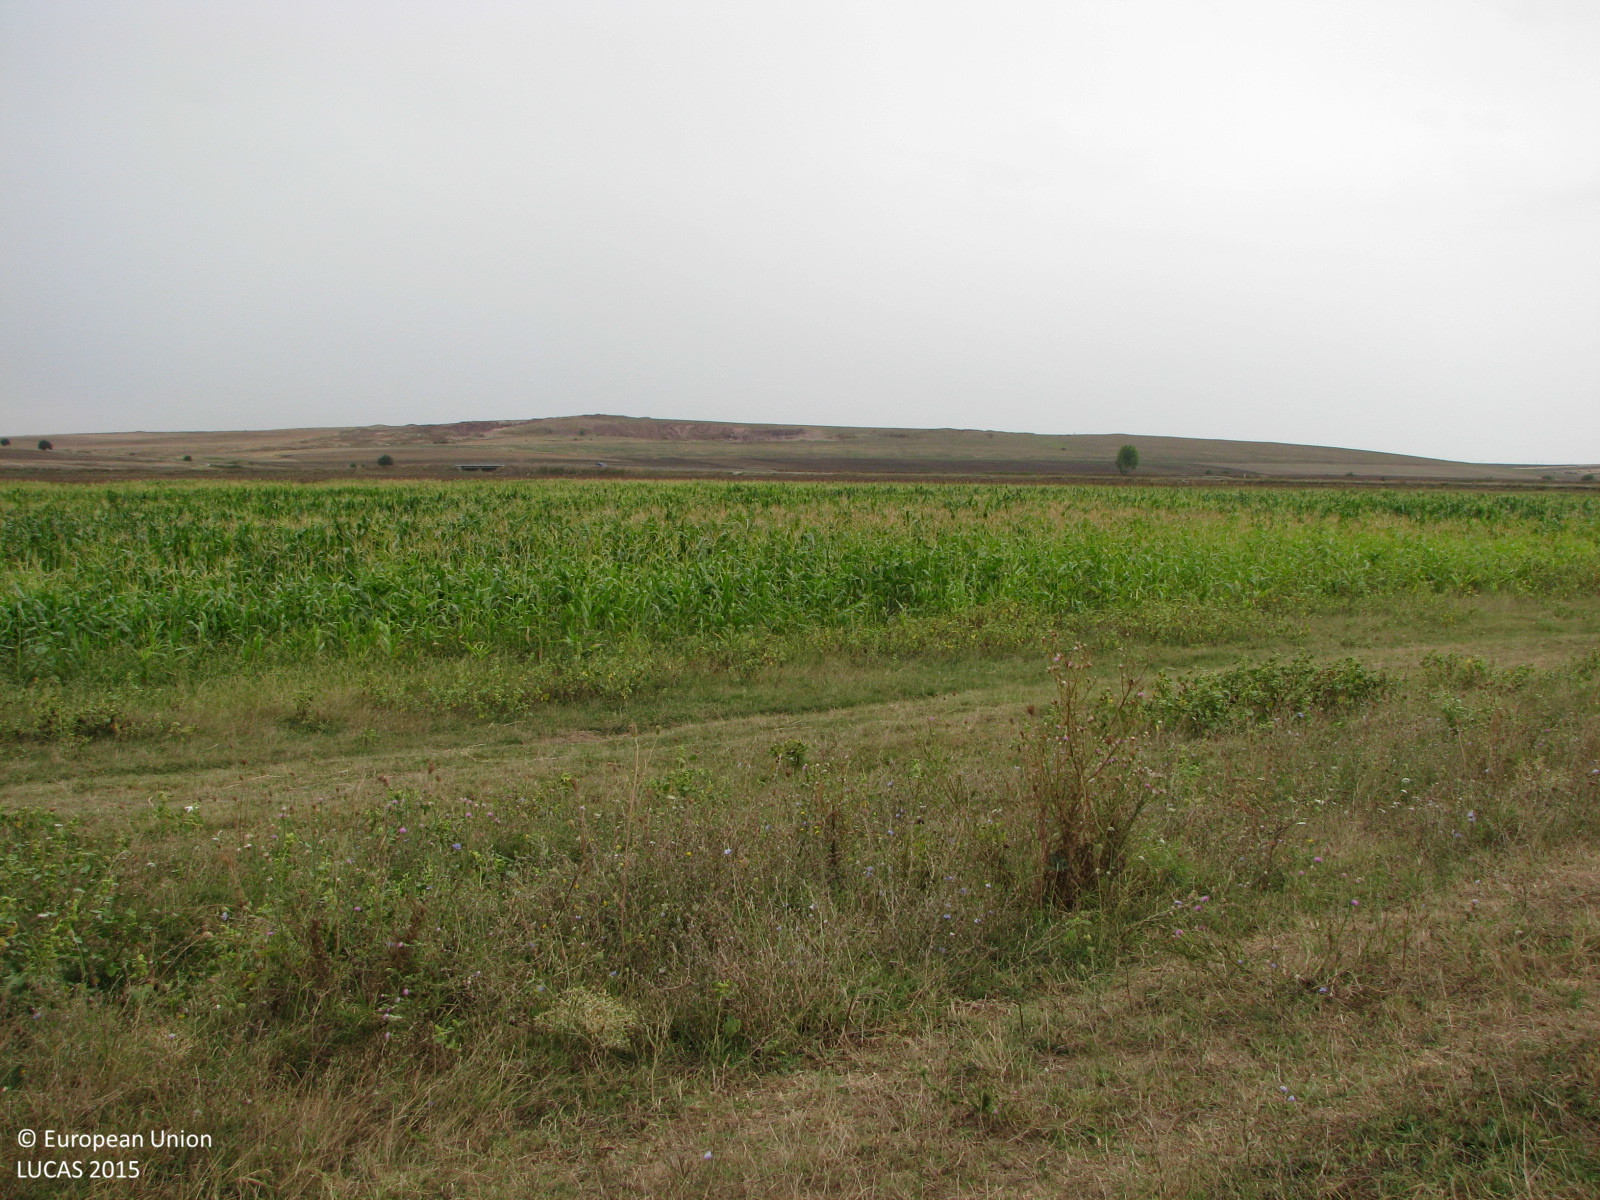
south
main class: Grassland
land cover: Grassland without tree/shrub cover
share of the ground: > 75 %
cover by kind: herbaceous plants 100 %
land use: Agriculture (excluding fallow land and kitchen gardens)
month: September
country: BG
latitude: 42.5296
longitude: 26.5661
